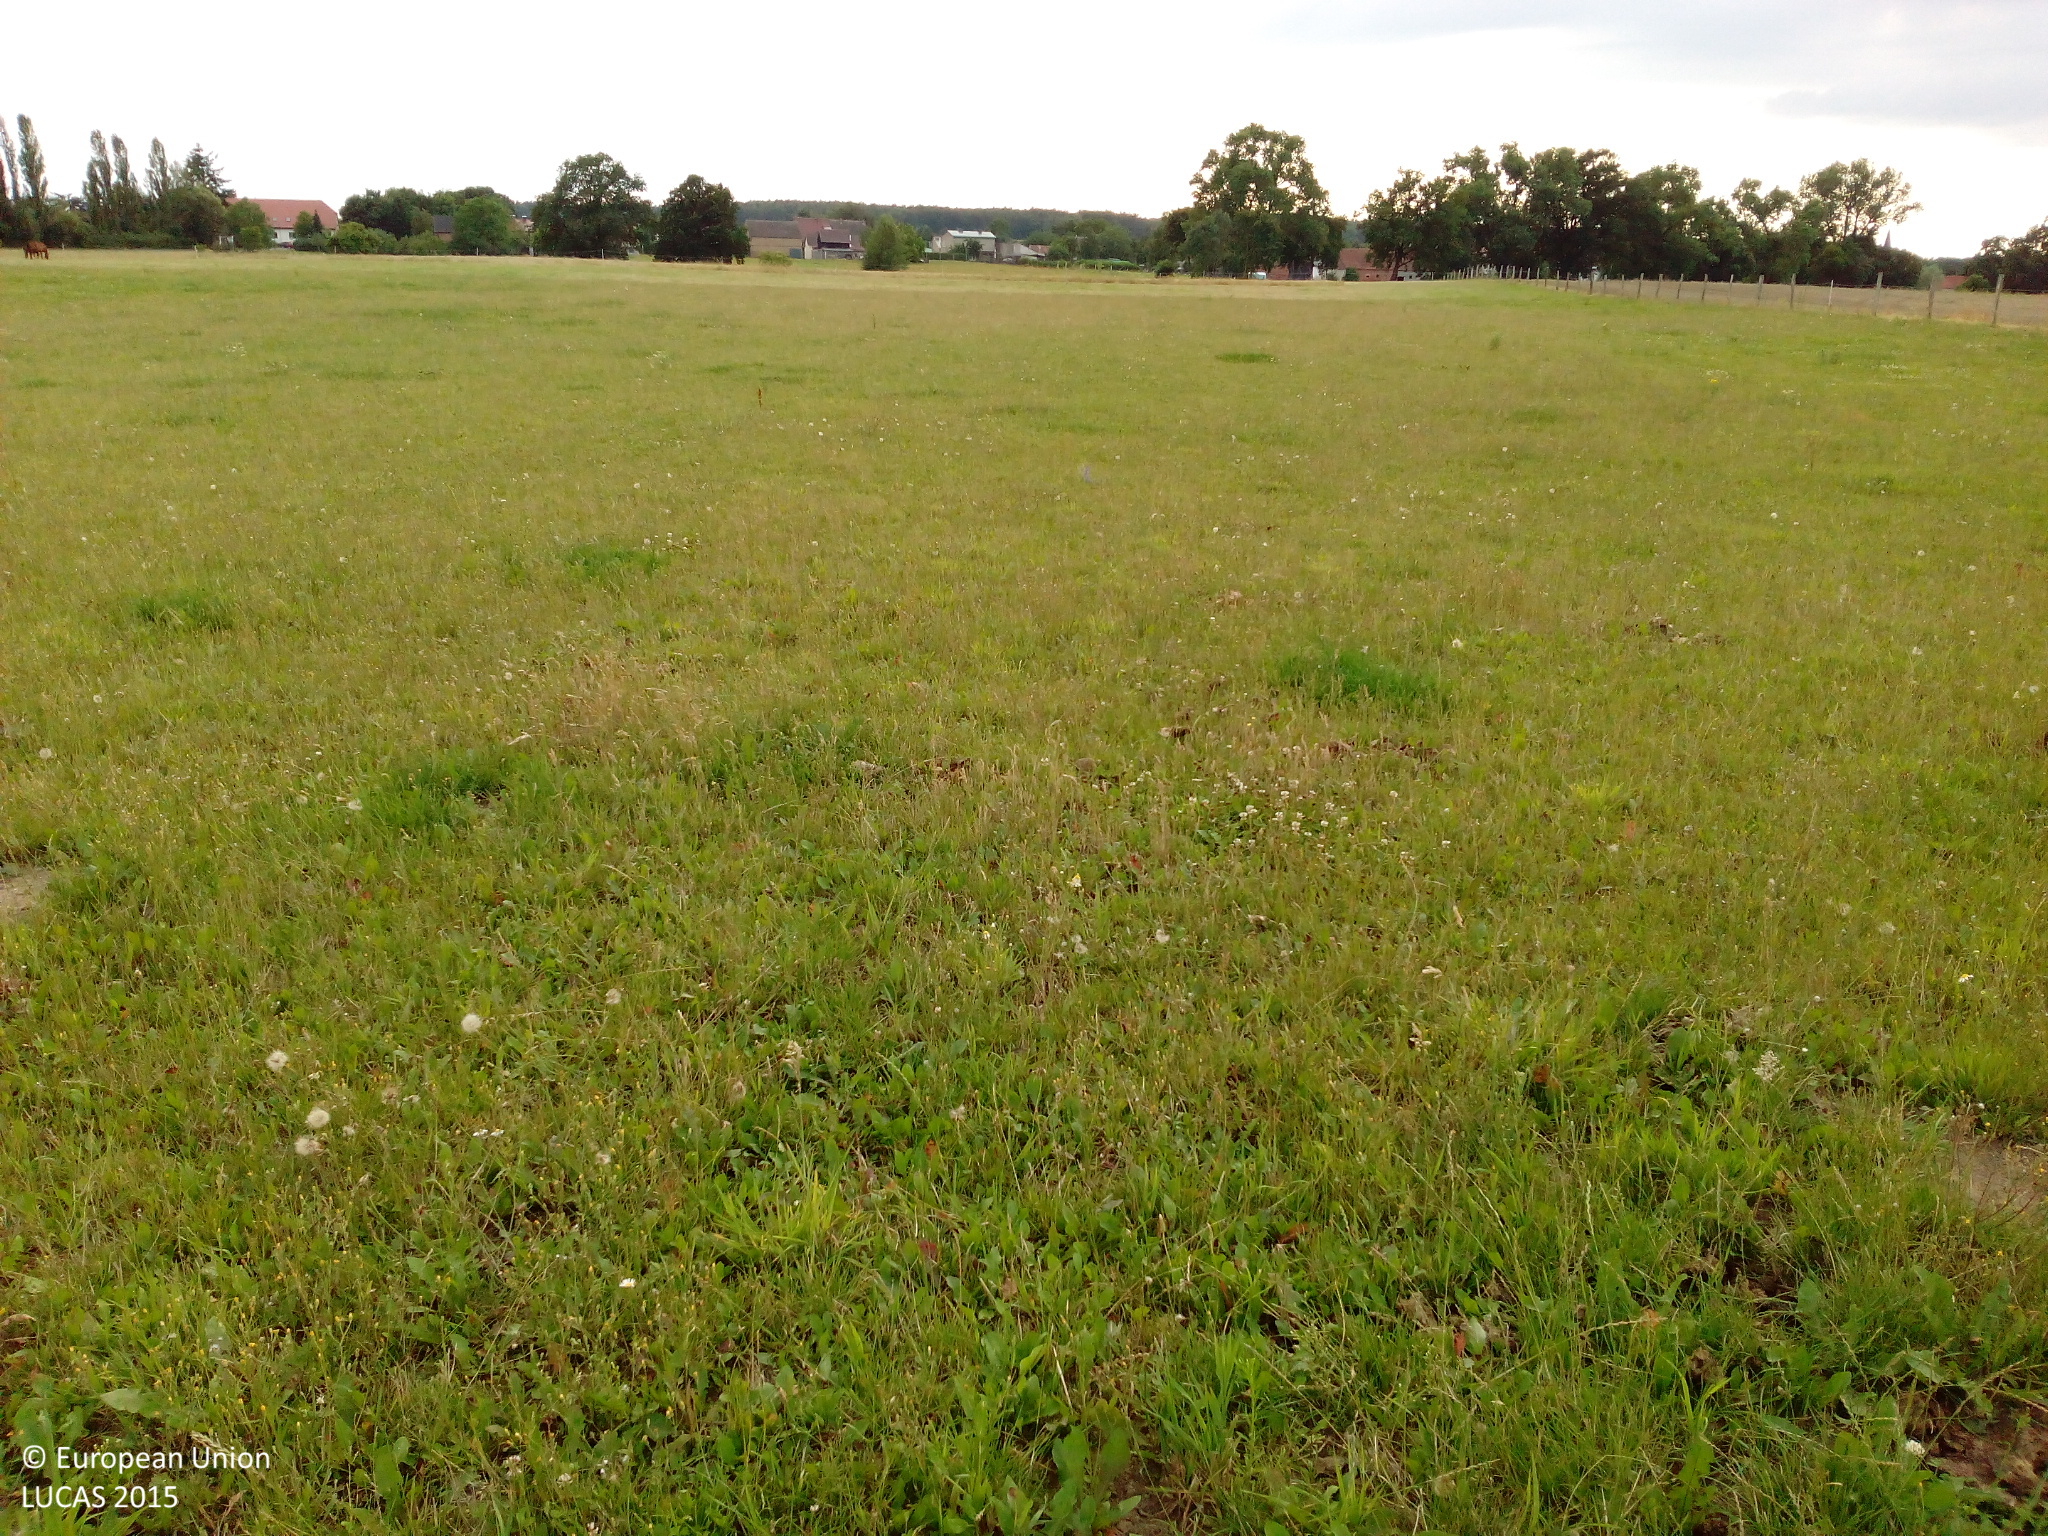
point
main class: Grassland
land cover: Grassland without tree/shrub cover
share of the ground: > 75 %
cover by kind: herbaceous plants 100 %
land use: Agriculture (excluding fallow land and kitchen gardens)
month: July
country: DE
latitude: 52.9479
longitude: 12.3360
